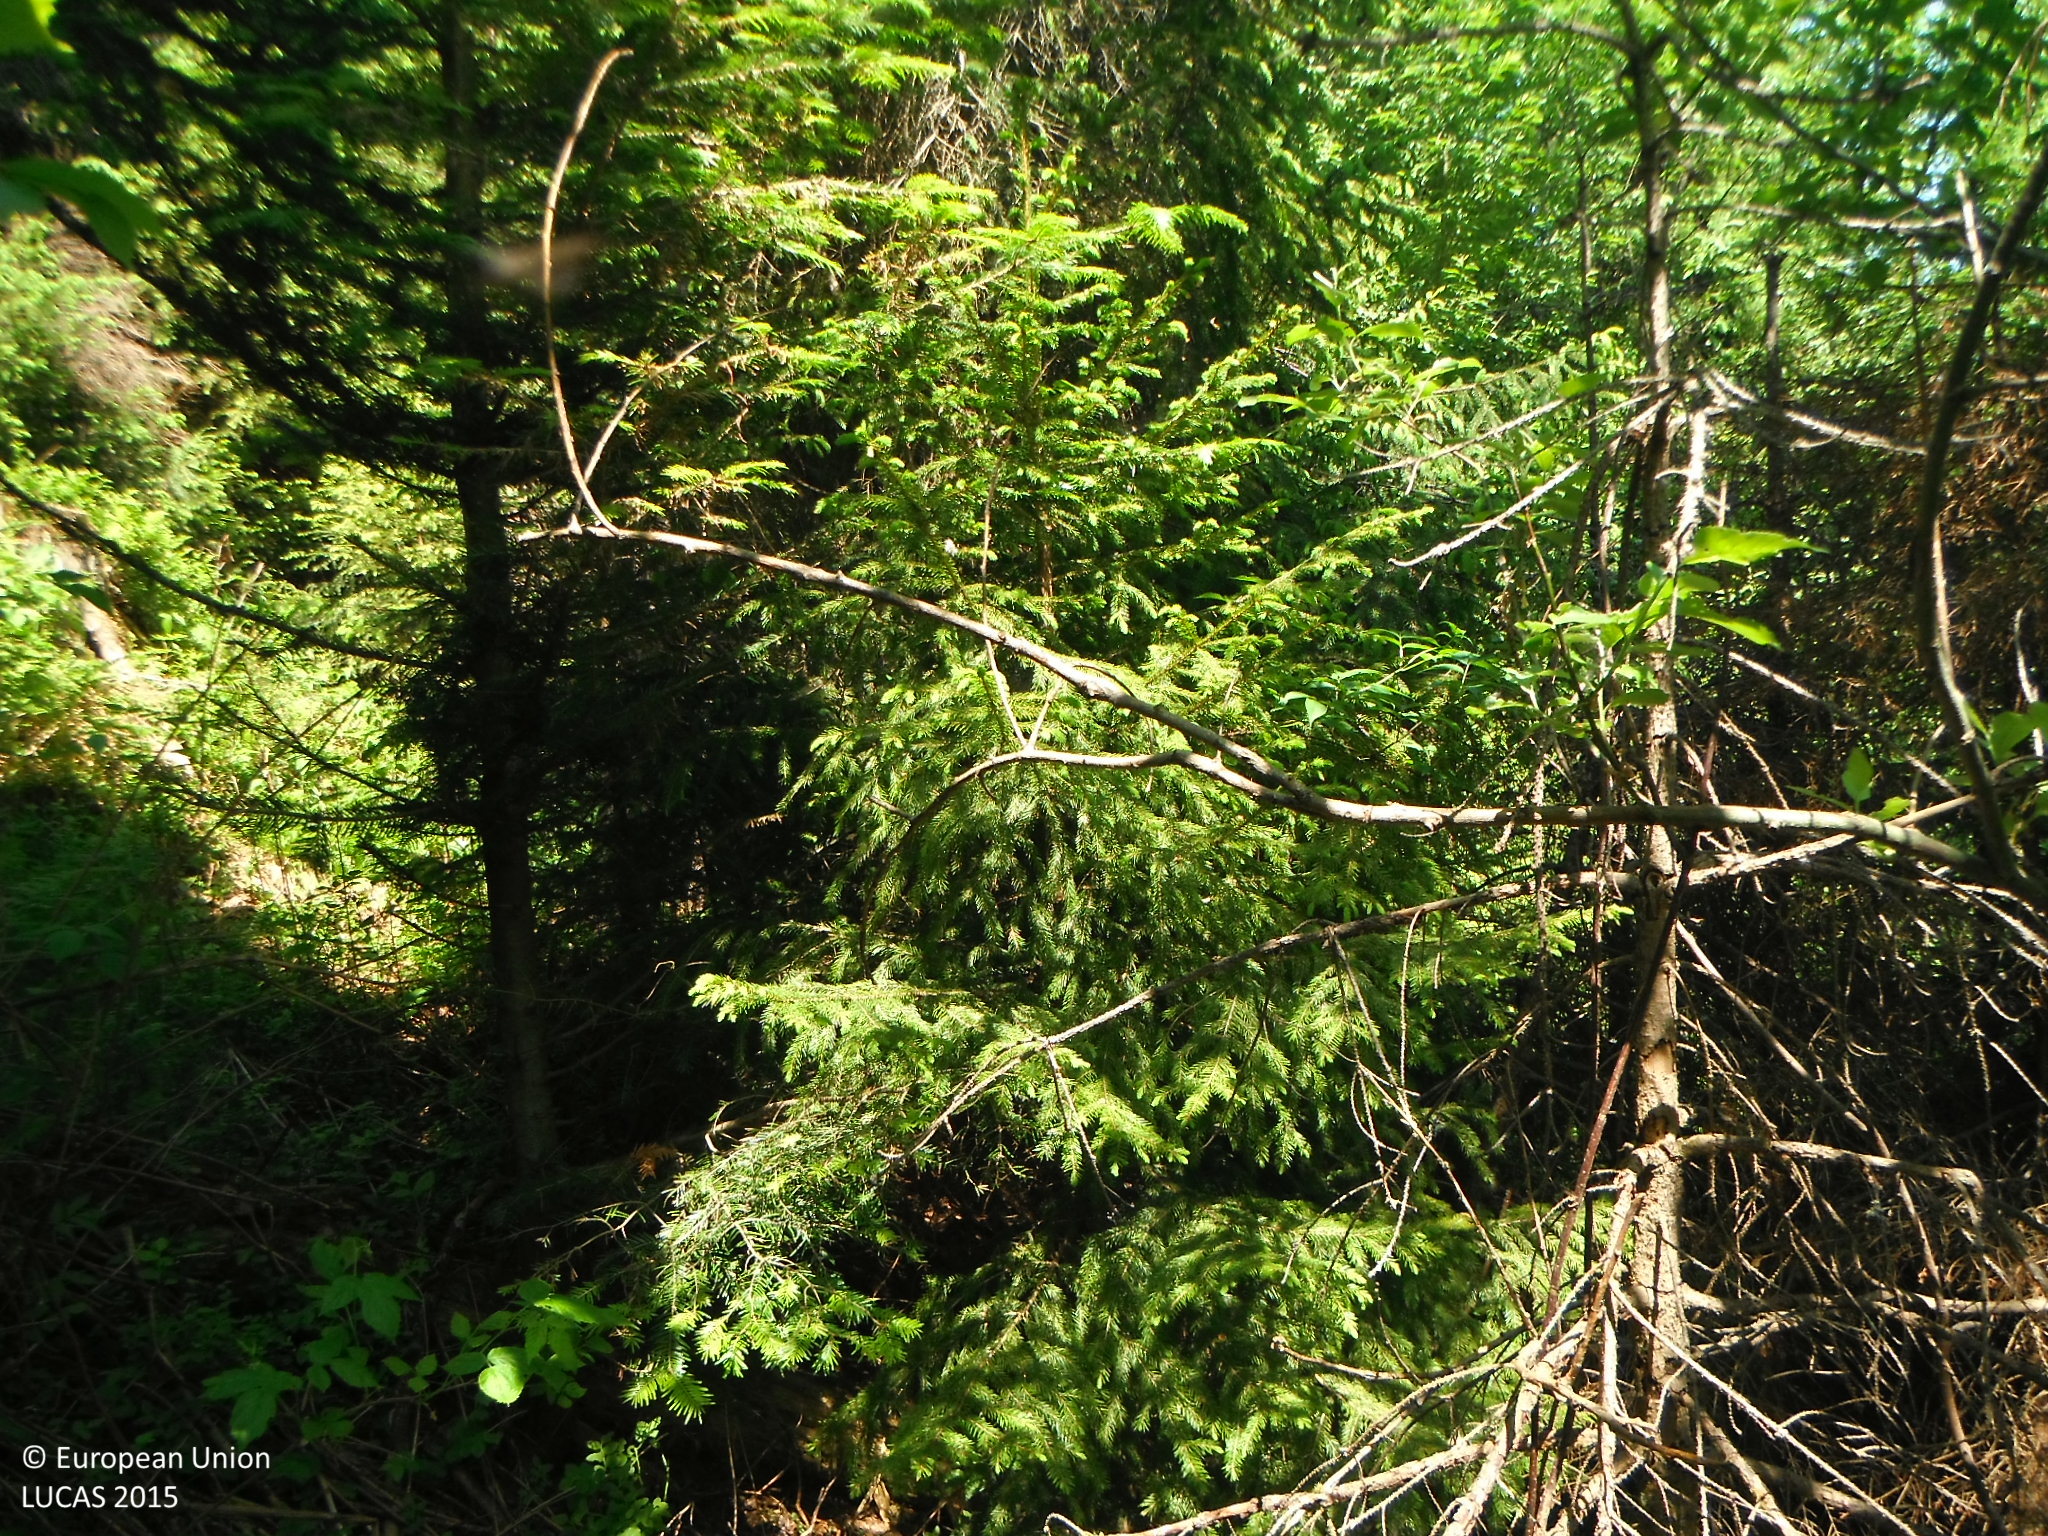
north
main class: Woodland
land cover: Other mixed woodland
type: hemiboreal forest and nemoral coniferous forest and mixed broadleaved-coniferous forest
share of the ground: > 75 %
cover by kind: coniferous forest trees 60 %, broadleaved forest trees 40 %
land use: Forestry
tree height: > 5 m
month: June
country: SK
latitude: 49.3216
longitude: 20.2561
